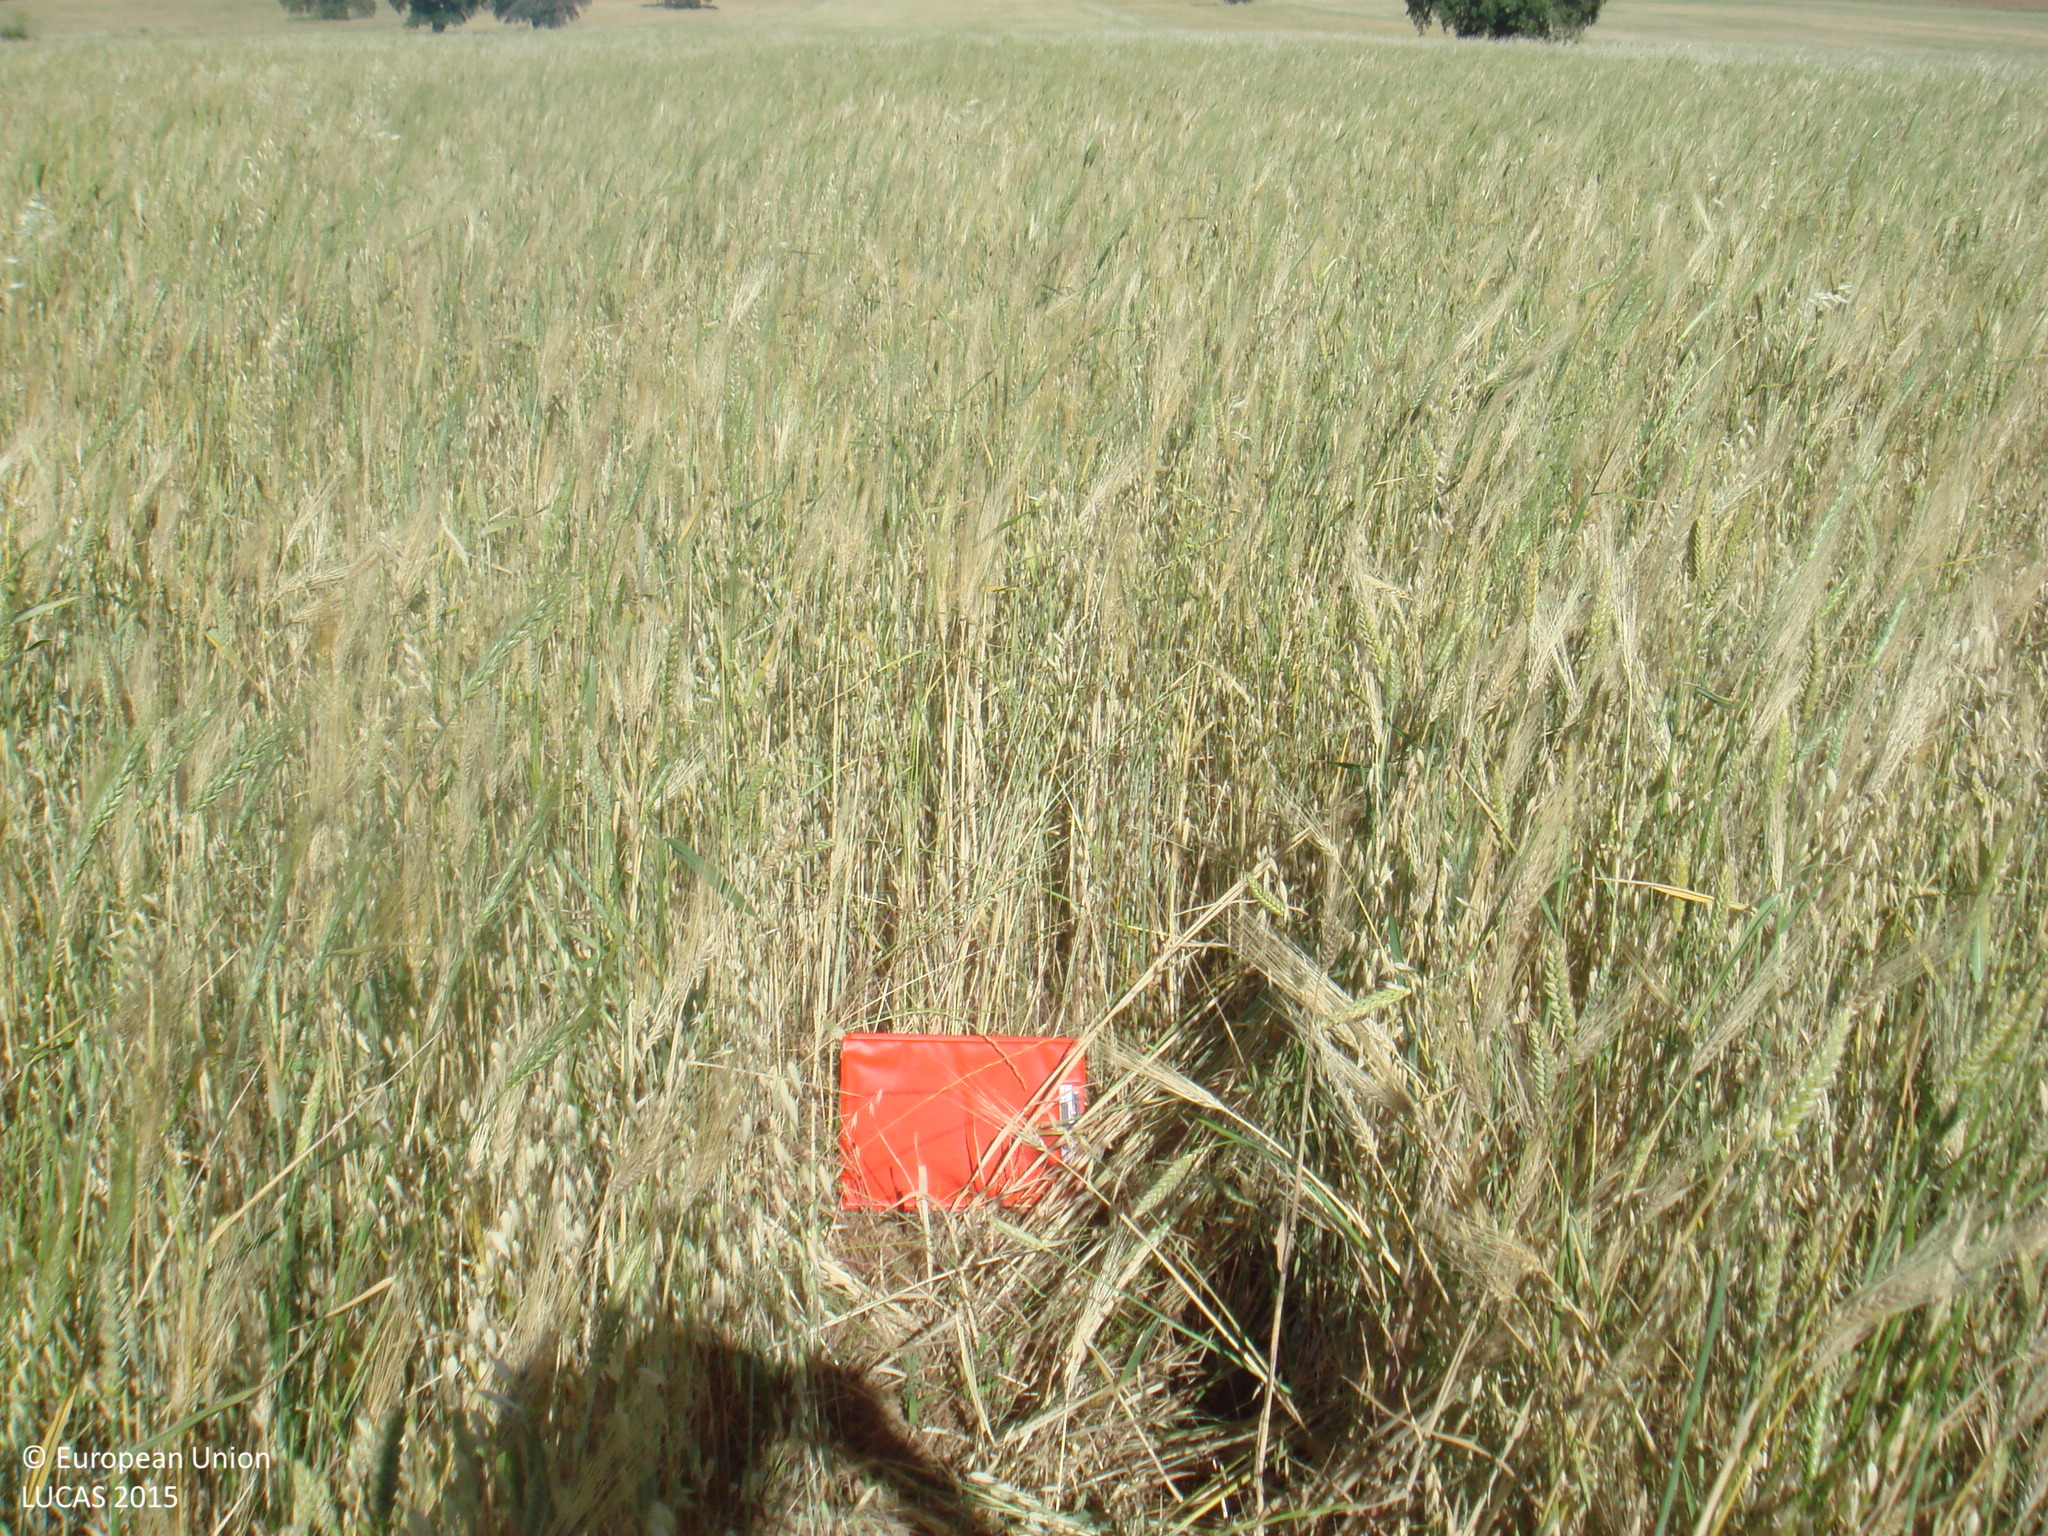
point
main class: Cropland
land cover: Mixed cereals for fodder
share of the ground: > 75 %
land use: Agriculture (excluding fallow land and kitchen gardens)
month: May
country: ES
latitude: 38.5372
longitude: -5.1160
